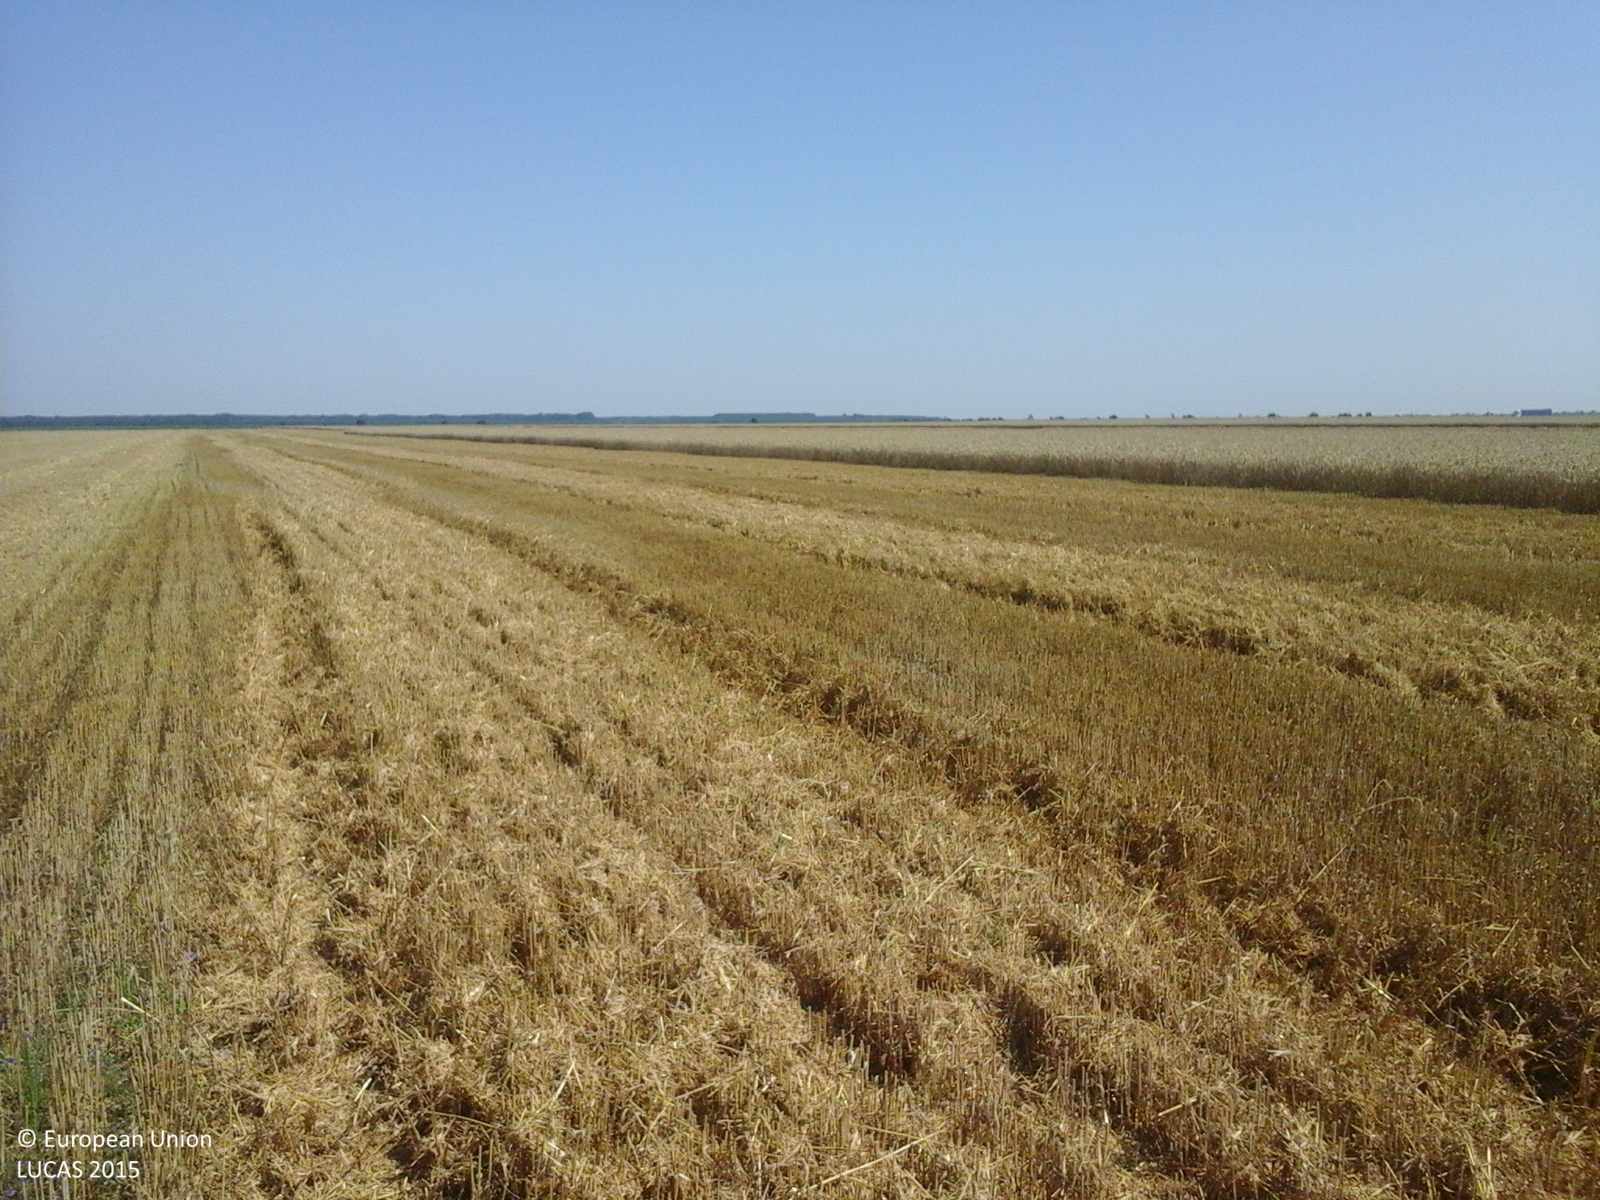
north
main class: Cropland
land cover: Common wheat
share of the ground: < 10 %
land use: Agriculture (excluding fallow land and kitchen gardens)
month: July
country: RO
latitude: 44.1307
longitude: 24.6308
